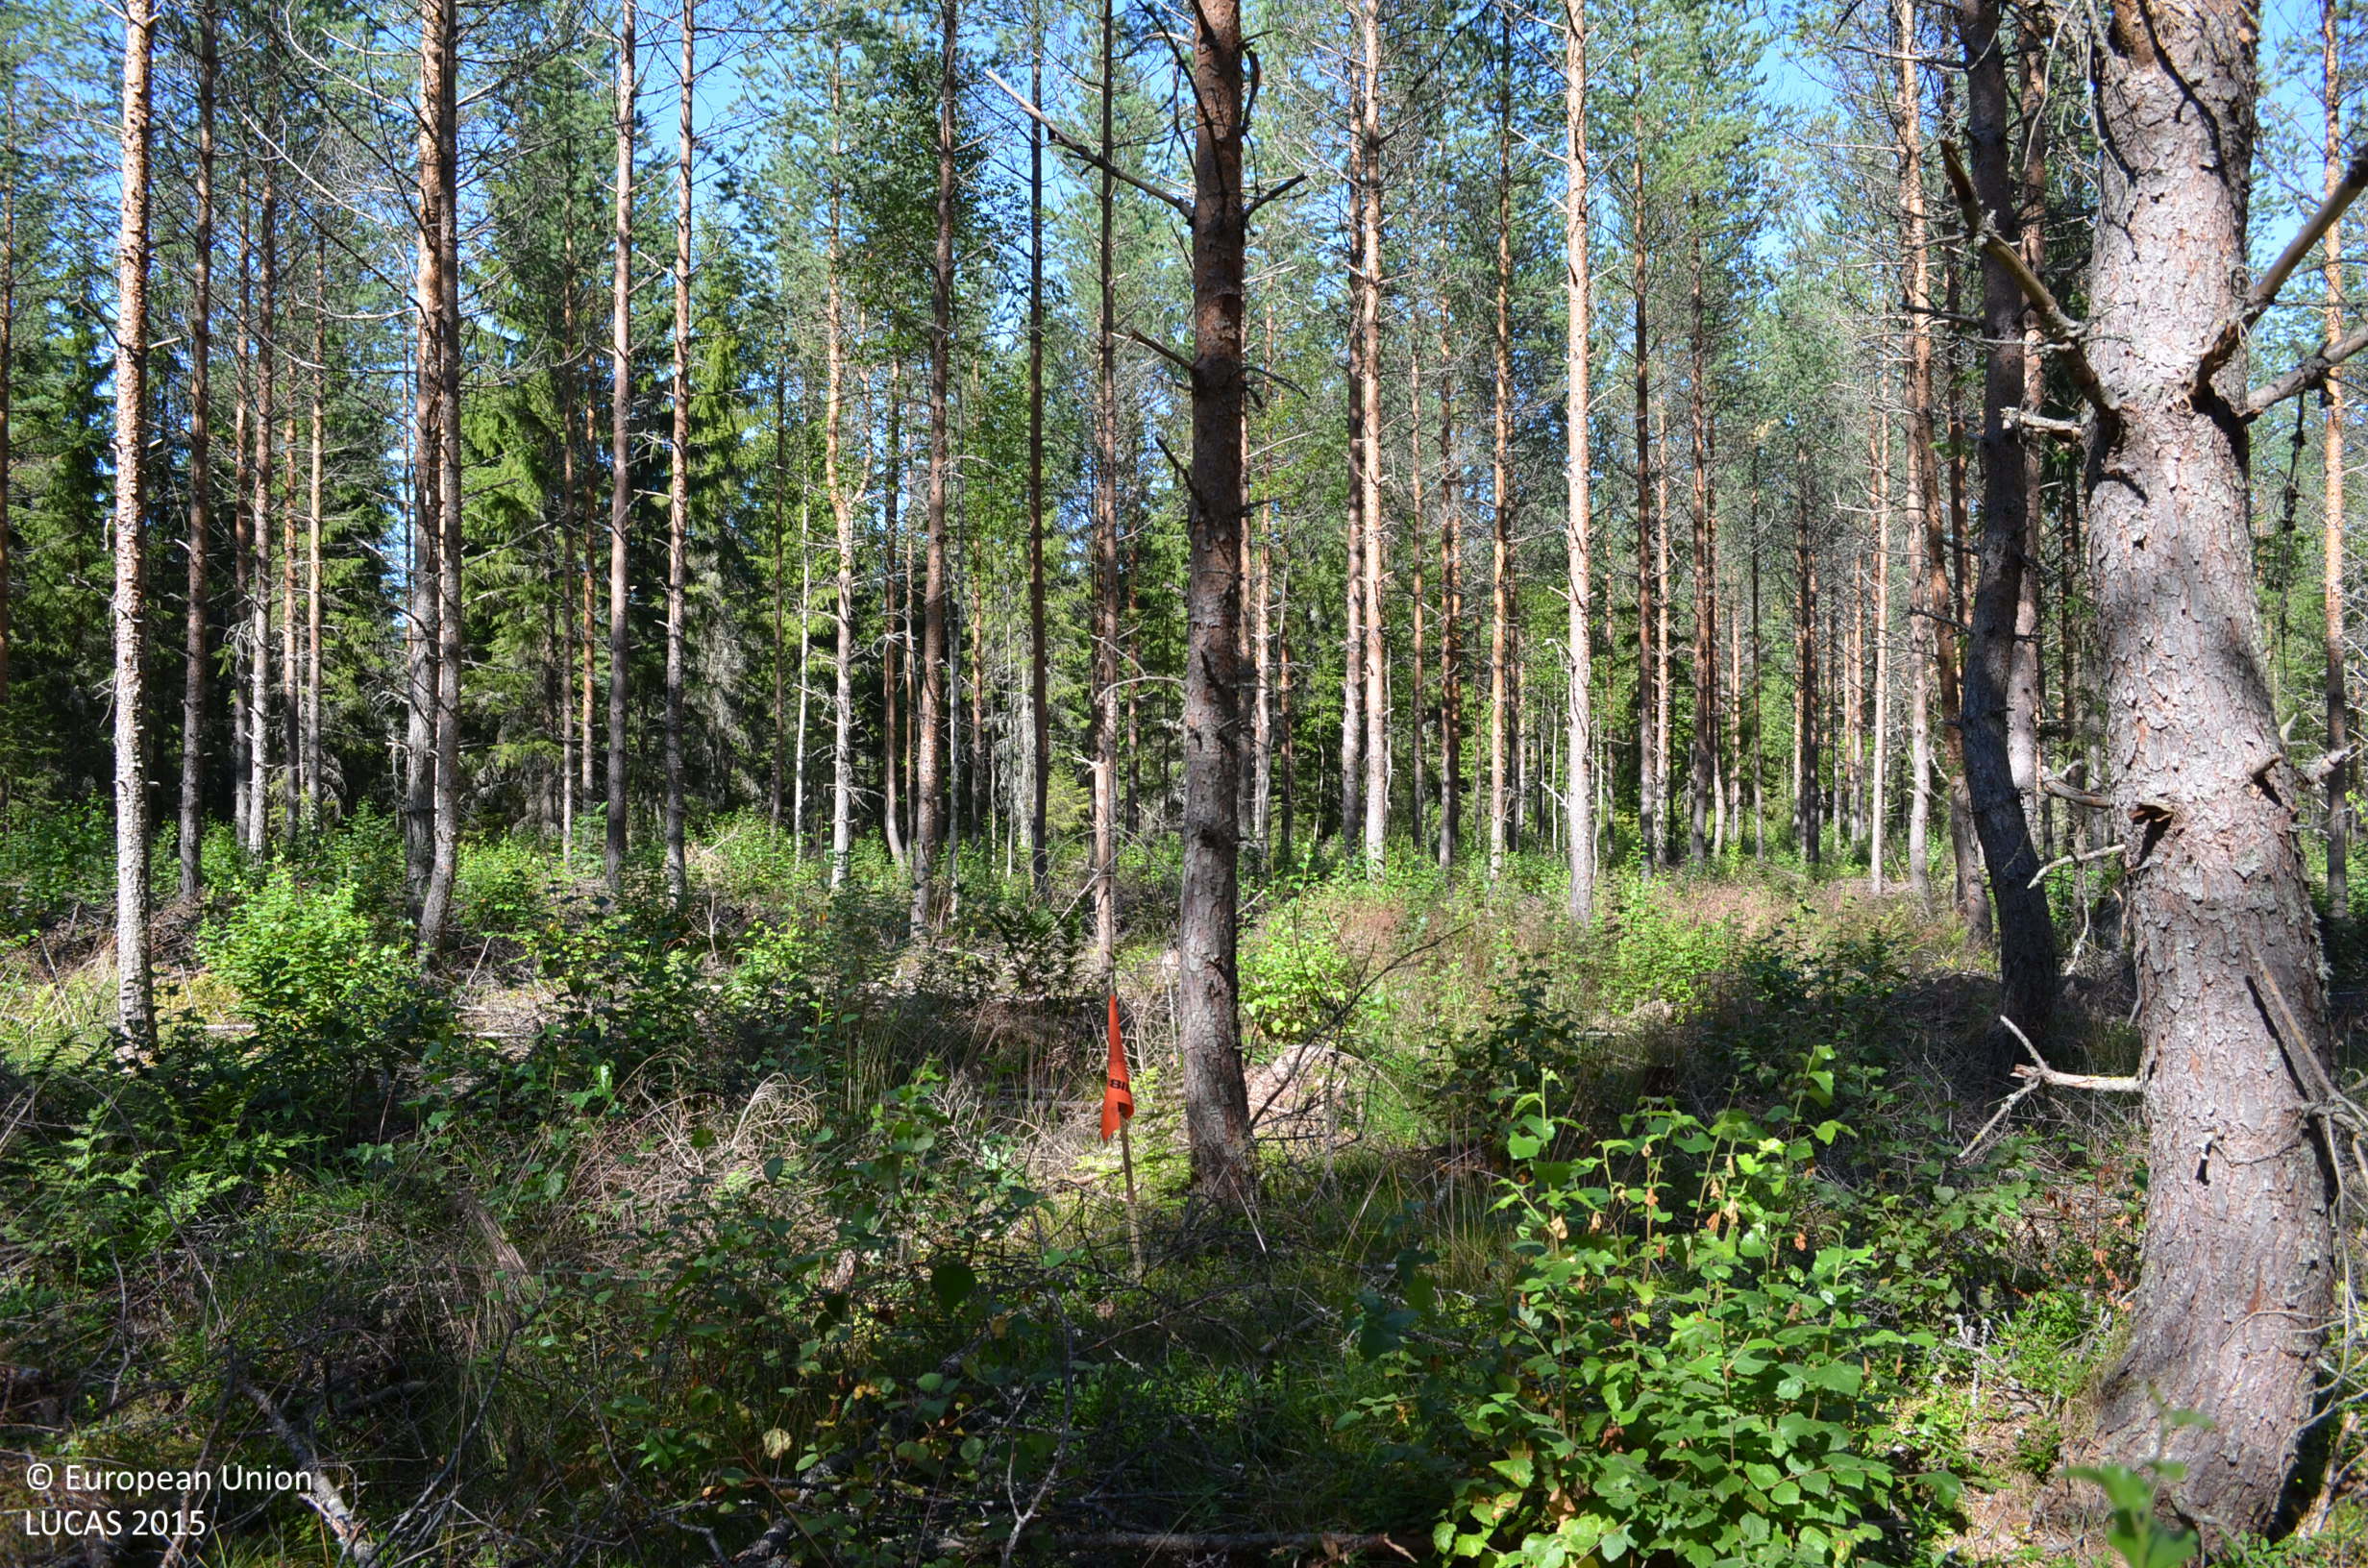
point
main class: Woodland
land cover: Pine dominated coniferous woodland
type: boreal forest
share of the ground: 50 - 75 %
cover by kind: coniferous forest trees 70 %, shrubs 20 %, herbaceous plants 5 %
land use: Forestry
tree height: > 5 m
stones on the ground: < 10 %
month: August
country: FI
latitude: 62.3456
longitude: 24.3211
